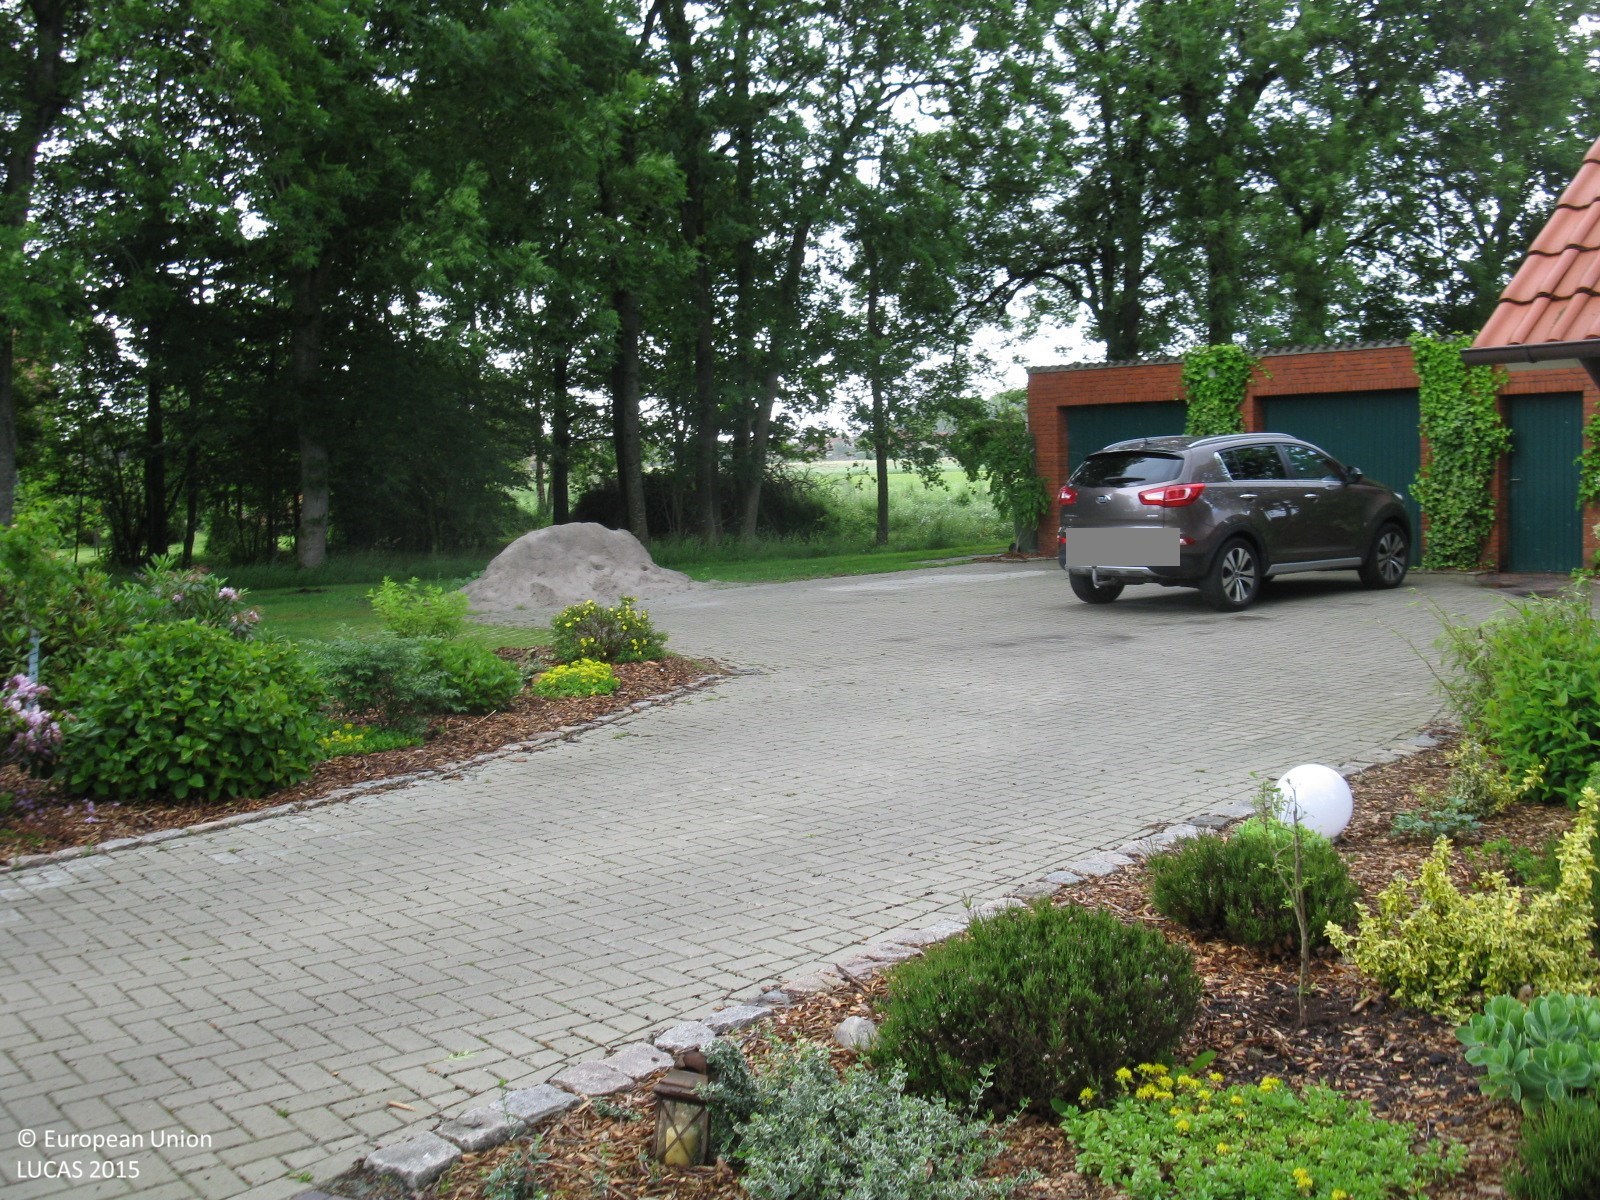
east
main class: Cropland
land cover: Floriculture and ornamental plants
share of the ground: > 75 %
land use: Residential
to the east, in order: Floriculture and ornamental plants; Artificial constructions in urban areas; Broadleaved woodland; Ditches and canals; Artificial constructions in urban areas; Grassland without tree/shrub cover; Maize; Ditches and canals; Grassland without tree/shrub cover; Ditches and canals; Maize
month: June
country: DE
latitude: 53.5171
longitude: 7.3614
